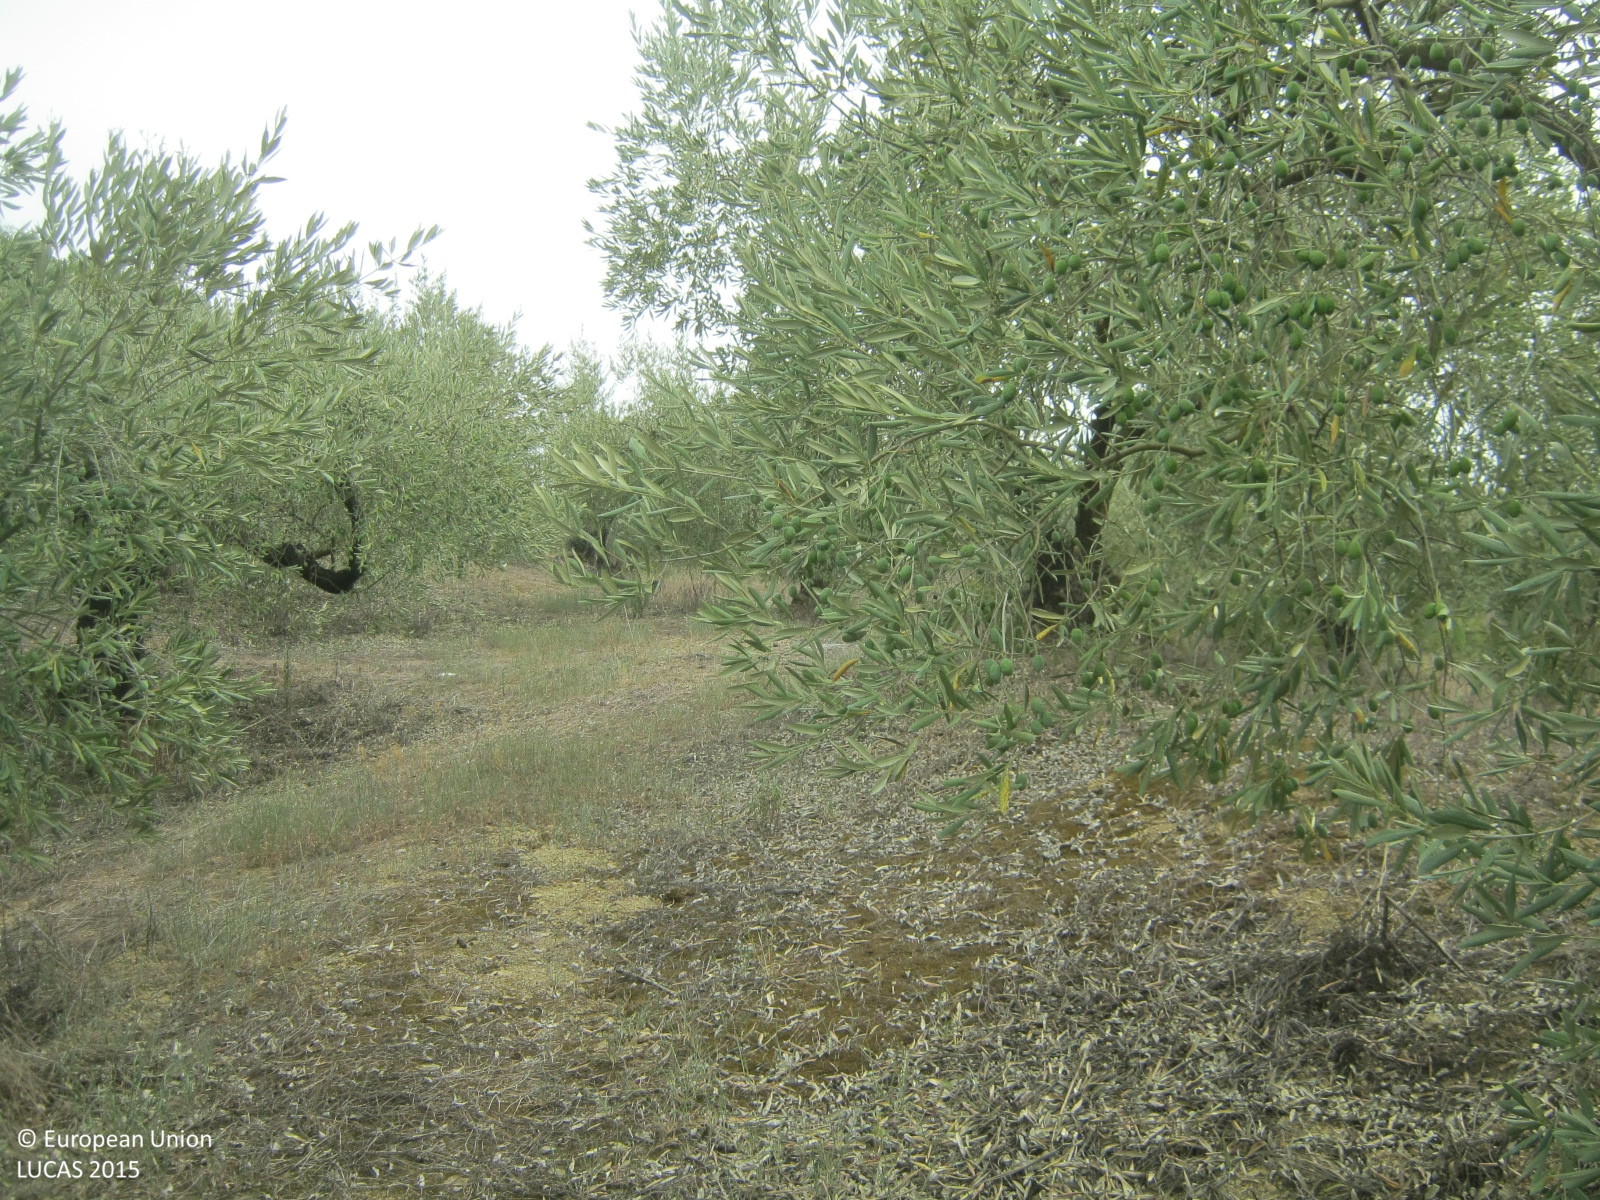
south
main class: Cropland
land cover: Olive groves
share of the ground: > 75 %
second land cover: Spontaneously vegetated surfaces
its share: > 75 %
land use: Agriculture (excluding fallow land and kitchen gardens)
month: September
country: GR
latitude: 39.1281
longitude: 21.0672
